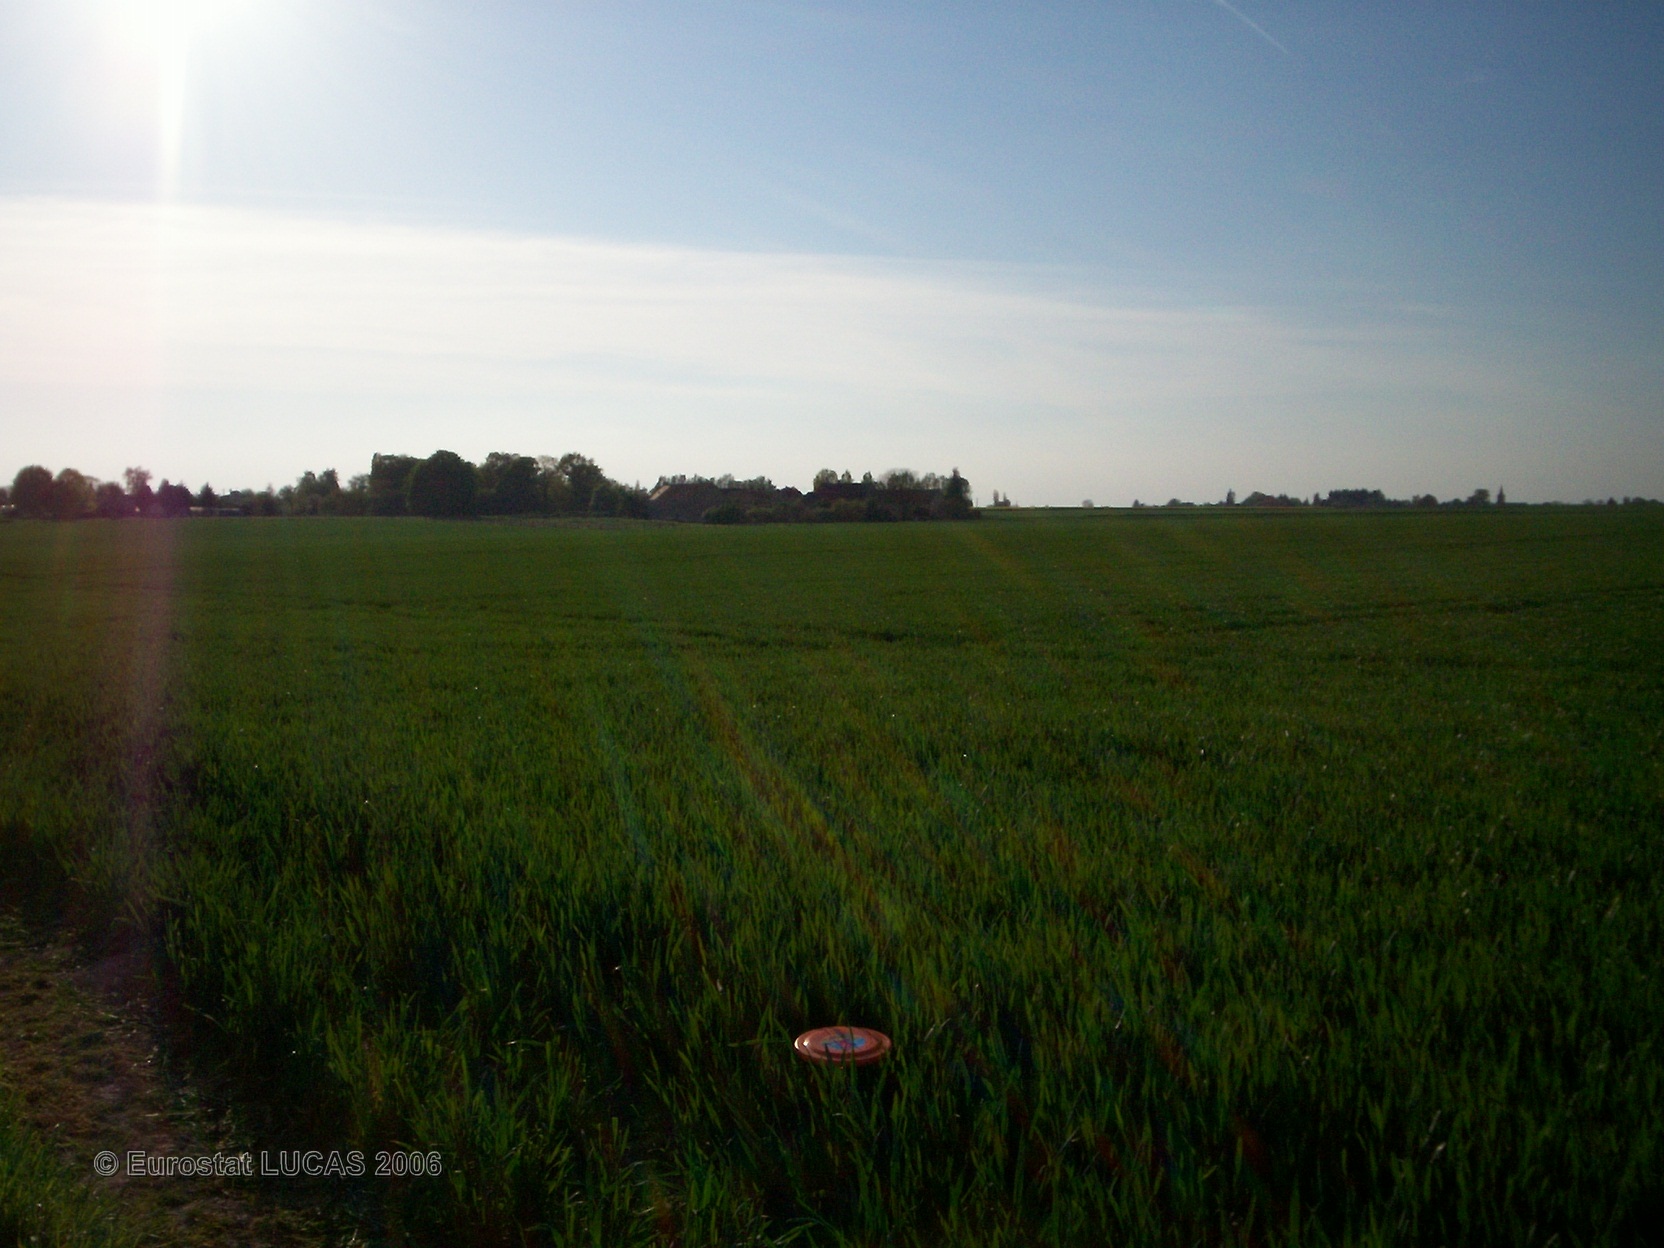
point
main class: Cropland
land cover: Common wheat
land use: Agriculture (excluding fallow land and kitchen gardens)
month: May
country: FR
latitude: 48.1968
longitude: 2.9560
